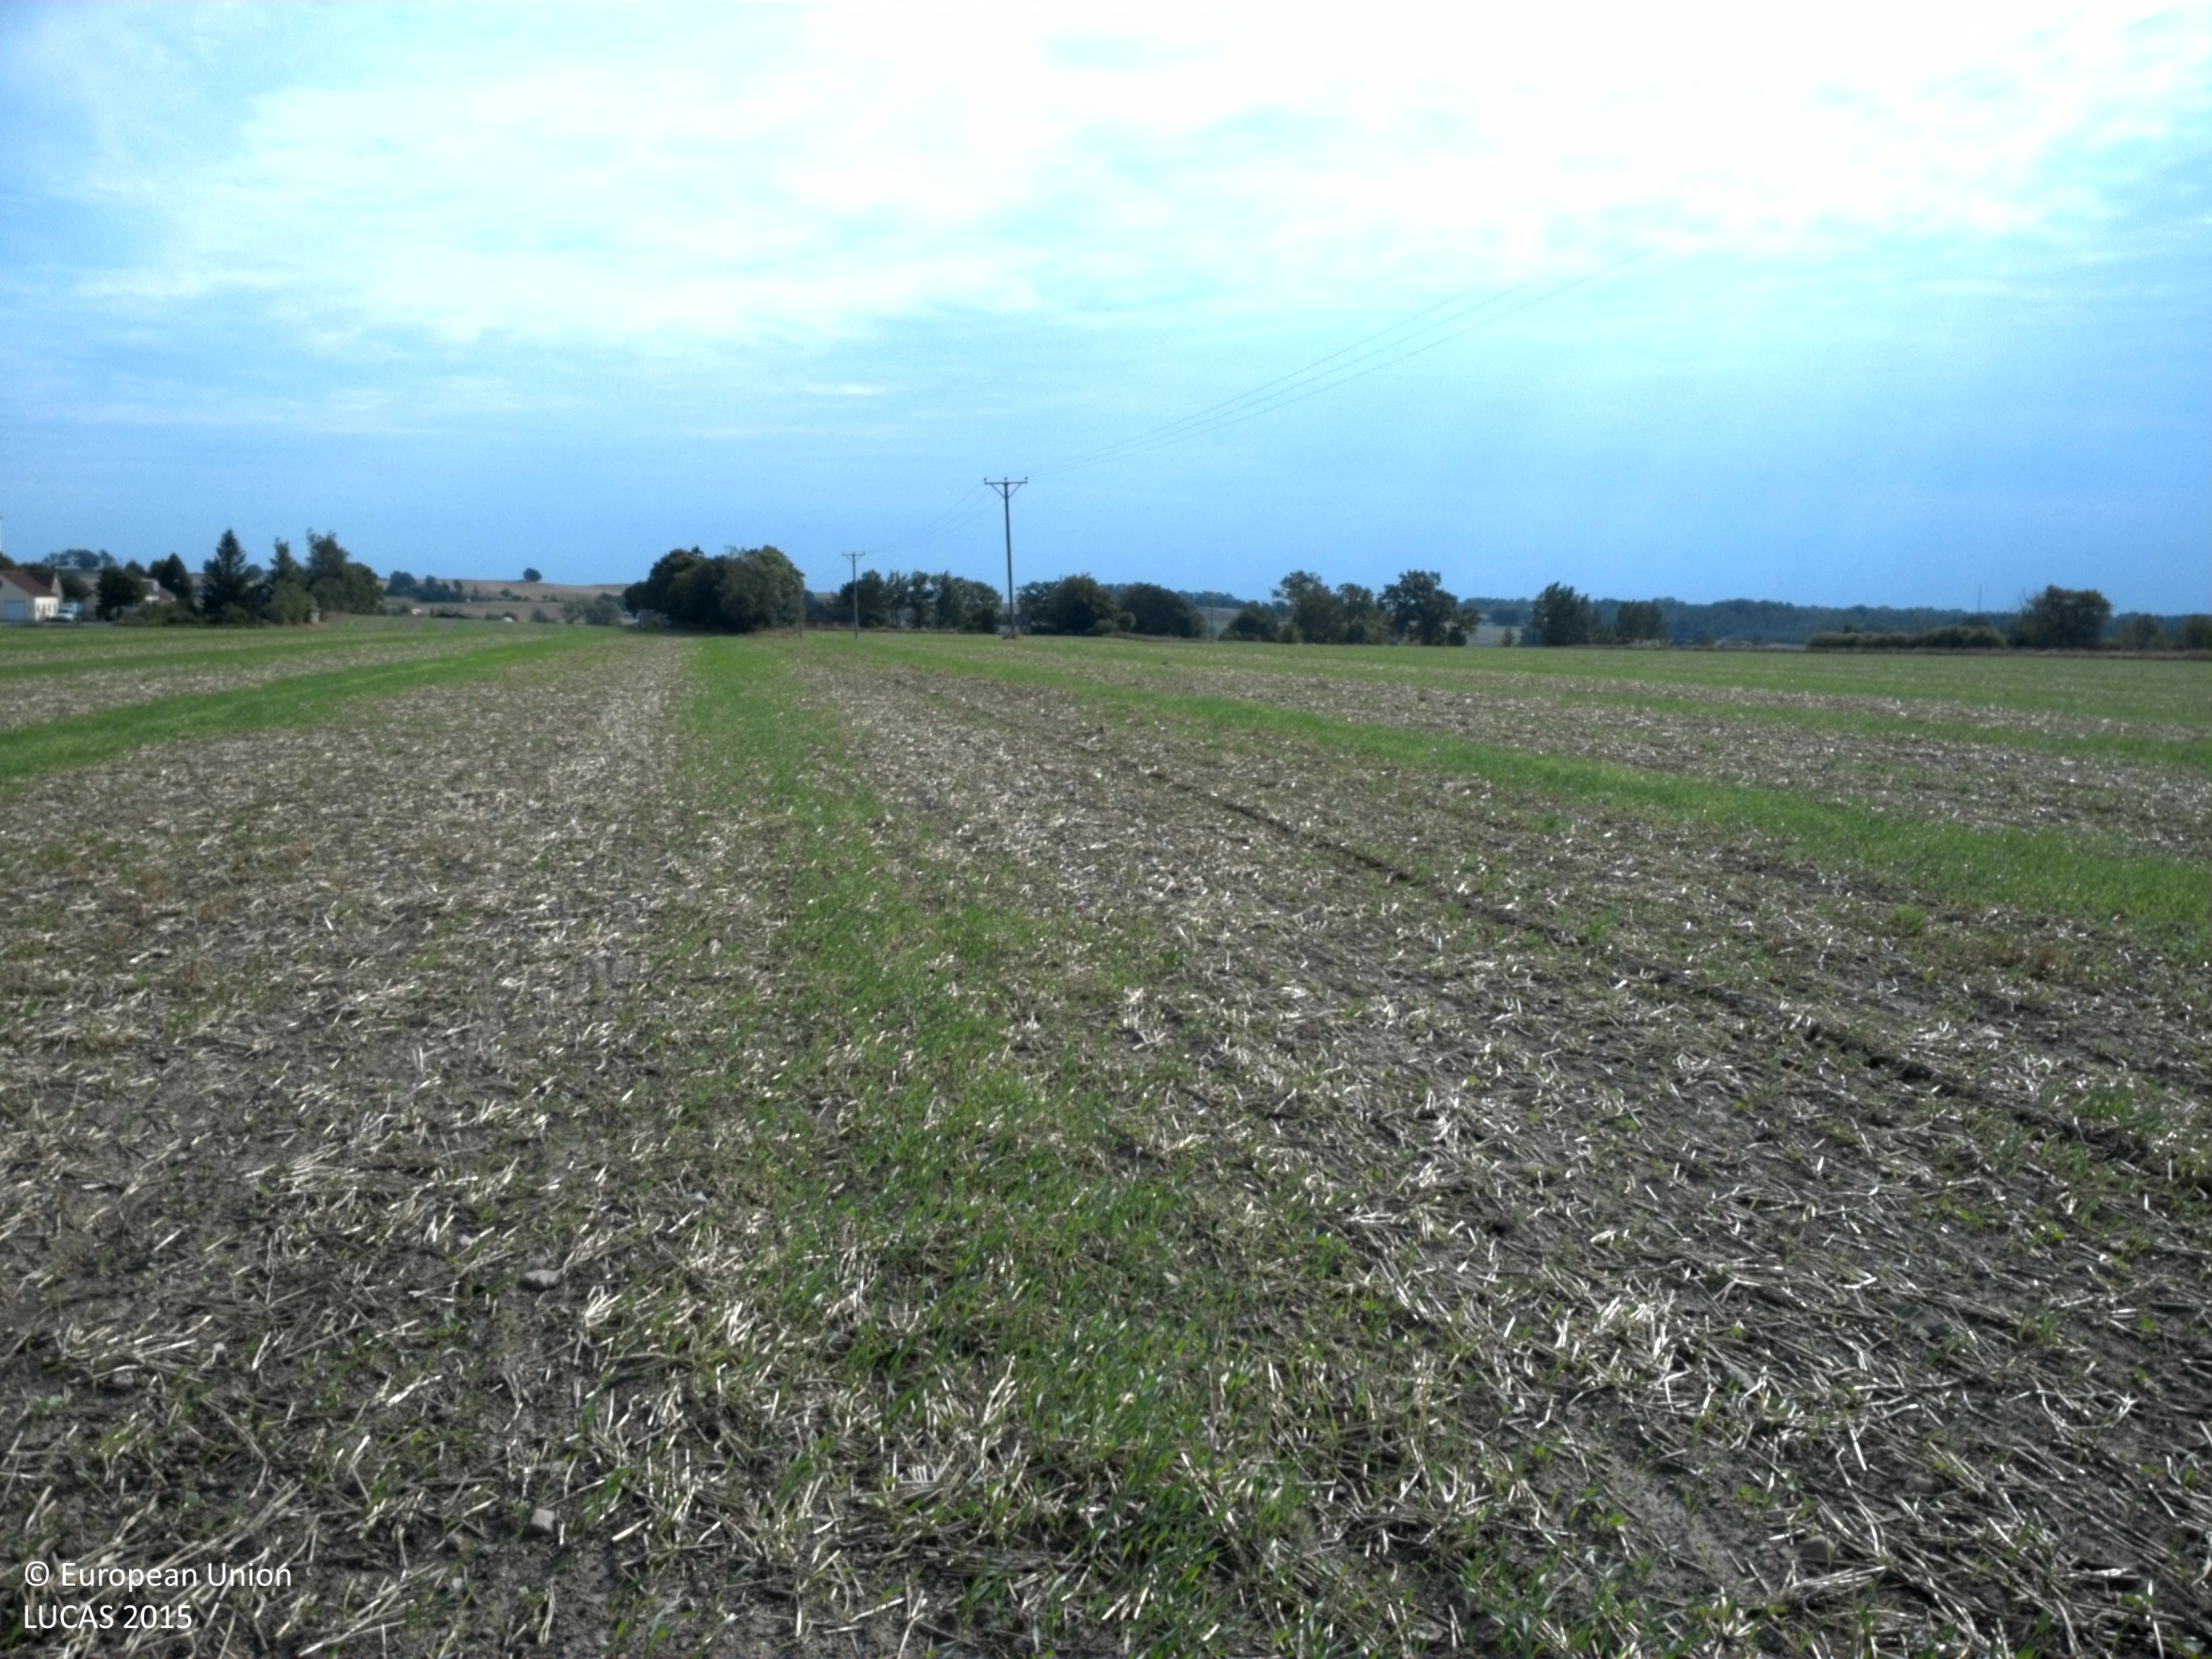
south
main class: Cropland
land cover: Other leguminous and mixtures for fodder
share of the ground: 10 - 25 %
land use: Agriculture (excluding fallow land and kitchen gardens)
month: September
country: SE
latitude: 55.5303
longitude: 14.0384
